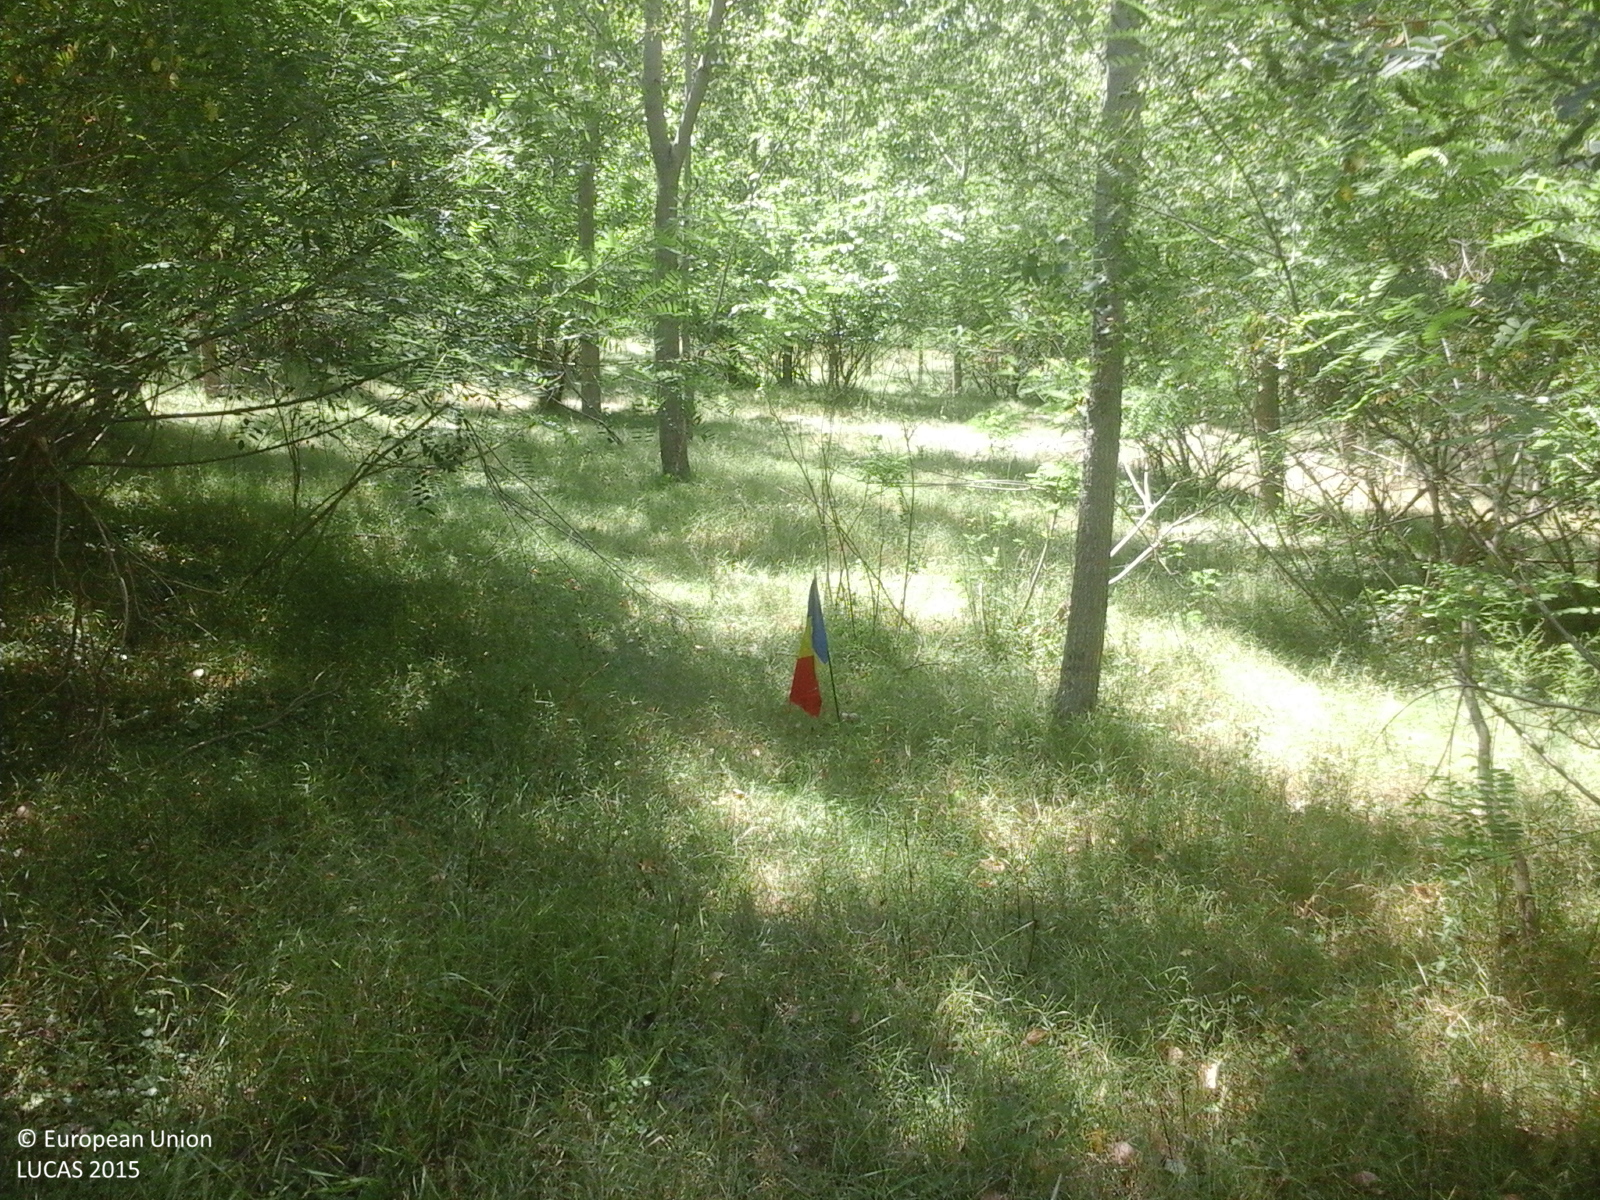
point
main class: Woodland
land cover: Broadleaved woodland
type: floodplain forest
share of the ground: > 75 %
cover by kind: broadleaved forest trees 80 %, herbaceous plants 20 %
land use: Forestry
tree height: > 5 m
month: July
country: RO
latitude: 44.1294
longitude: 27.4470
